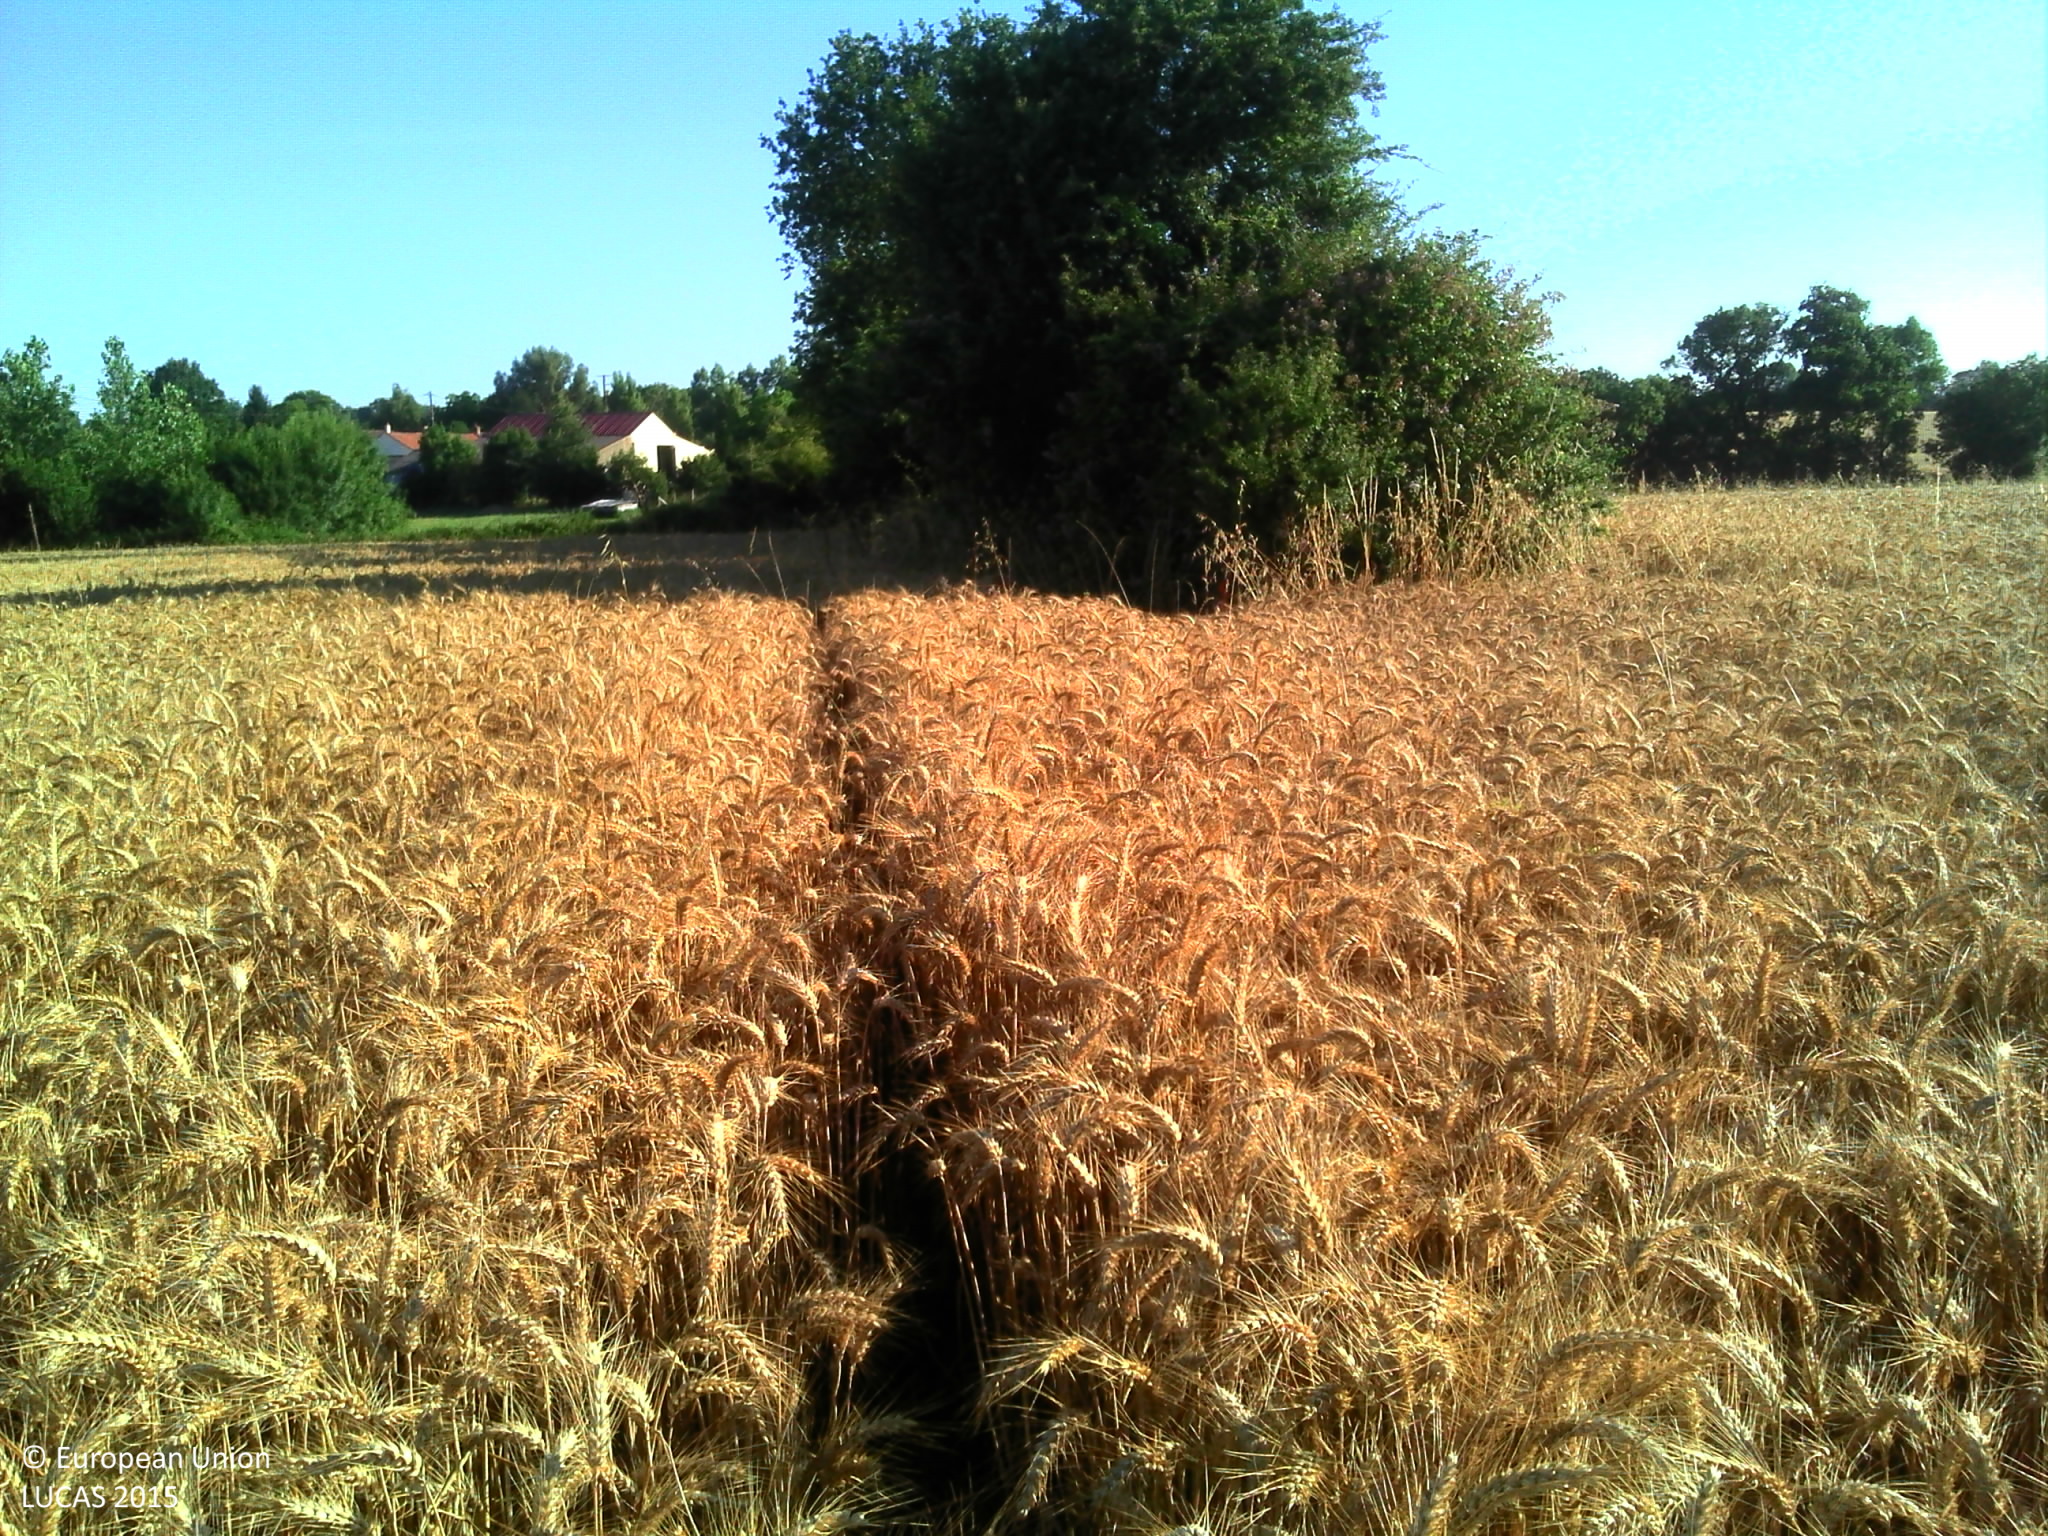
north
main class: Cropland
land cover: Common wheat
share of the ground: > 75 %
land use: Agriculture (excluding fallow land and kitchen gardens)
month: July
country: FR
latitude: 47.1307
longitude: -1.8178
